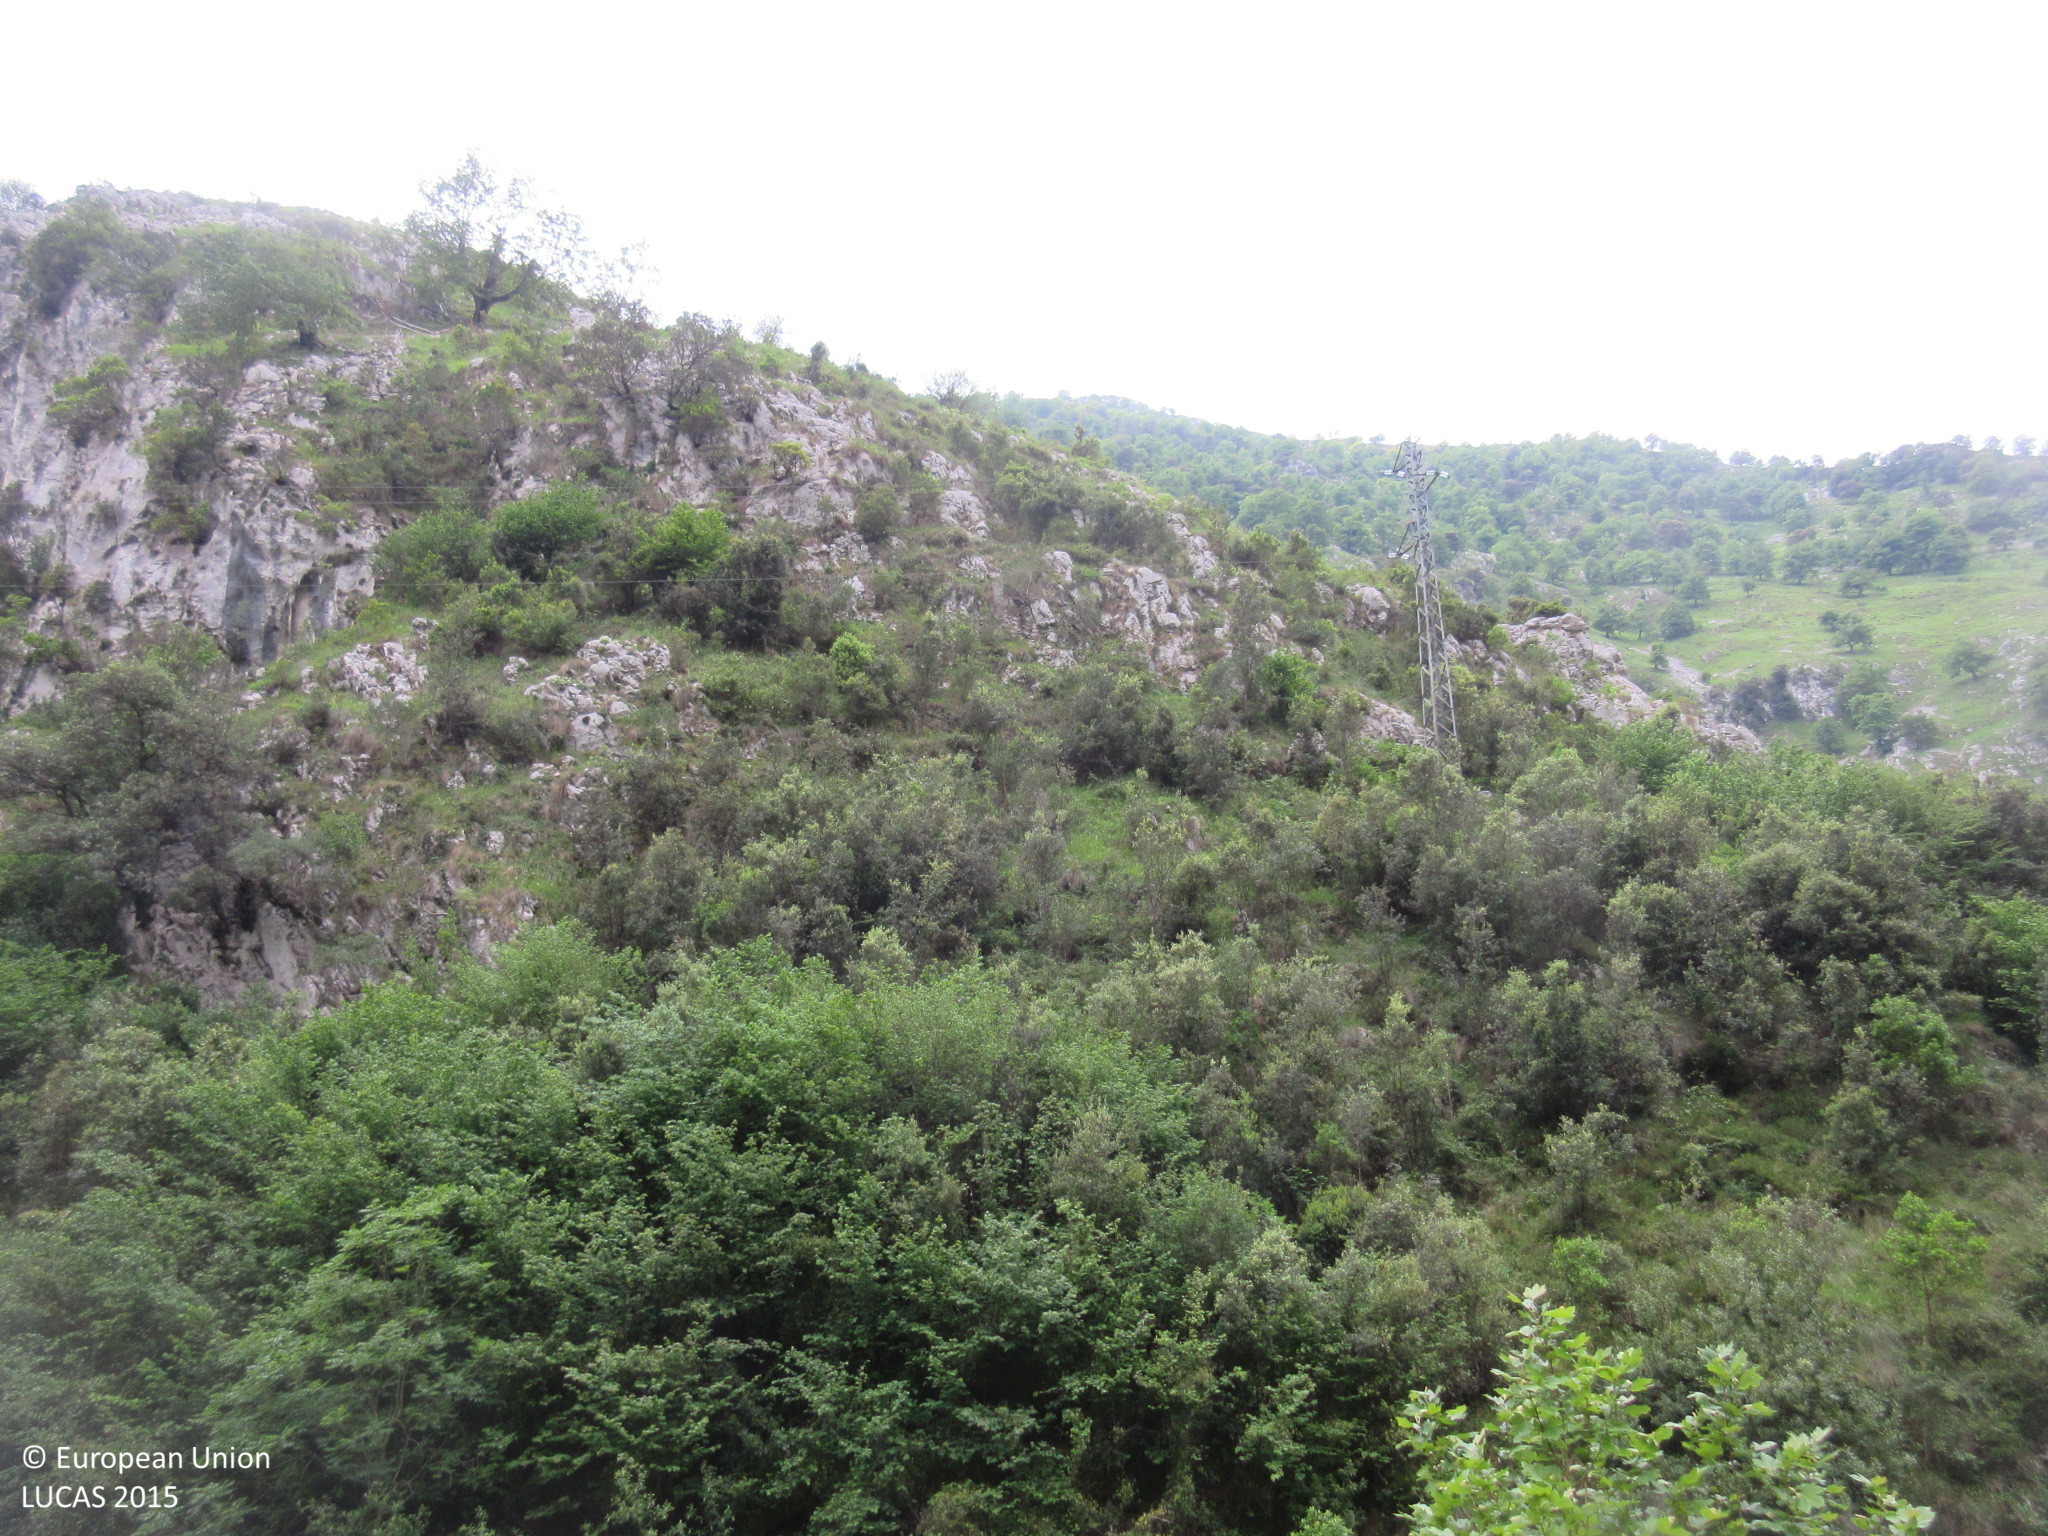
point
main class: Woodland
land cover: Broadleaved woodland
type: floodplain forest
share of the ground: > 75 %
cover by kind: broadleaved forest trees 80 %, shrubs 20 %
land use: Semi-natural and natural areas not in use
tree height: > 5 m
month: May
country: ES
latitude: 43.2906
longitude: -4.6174
